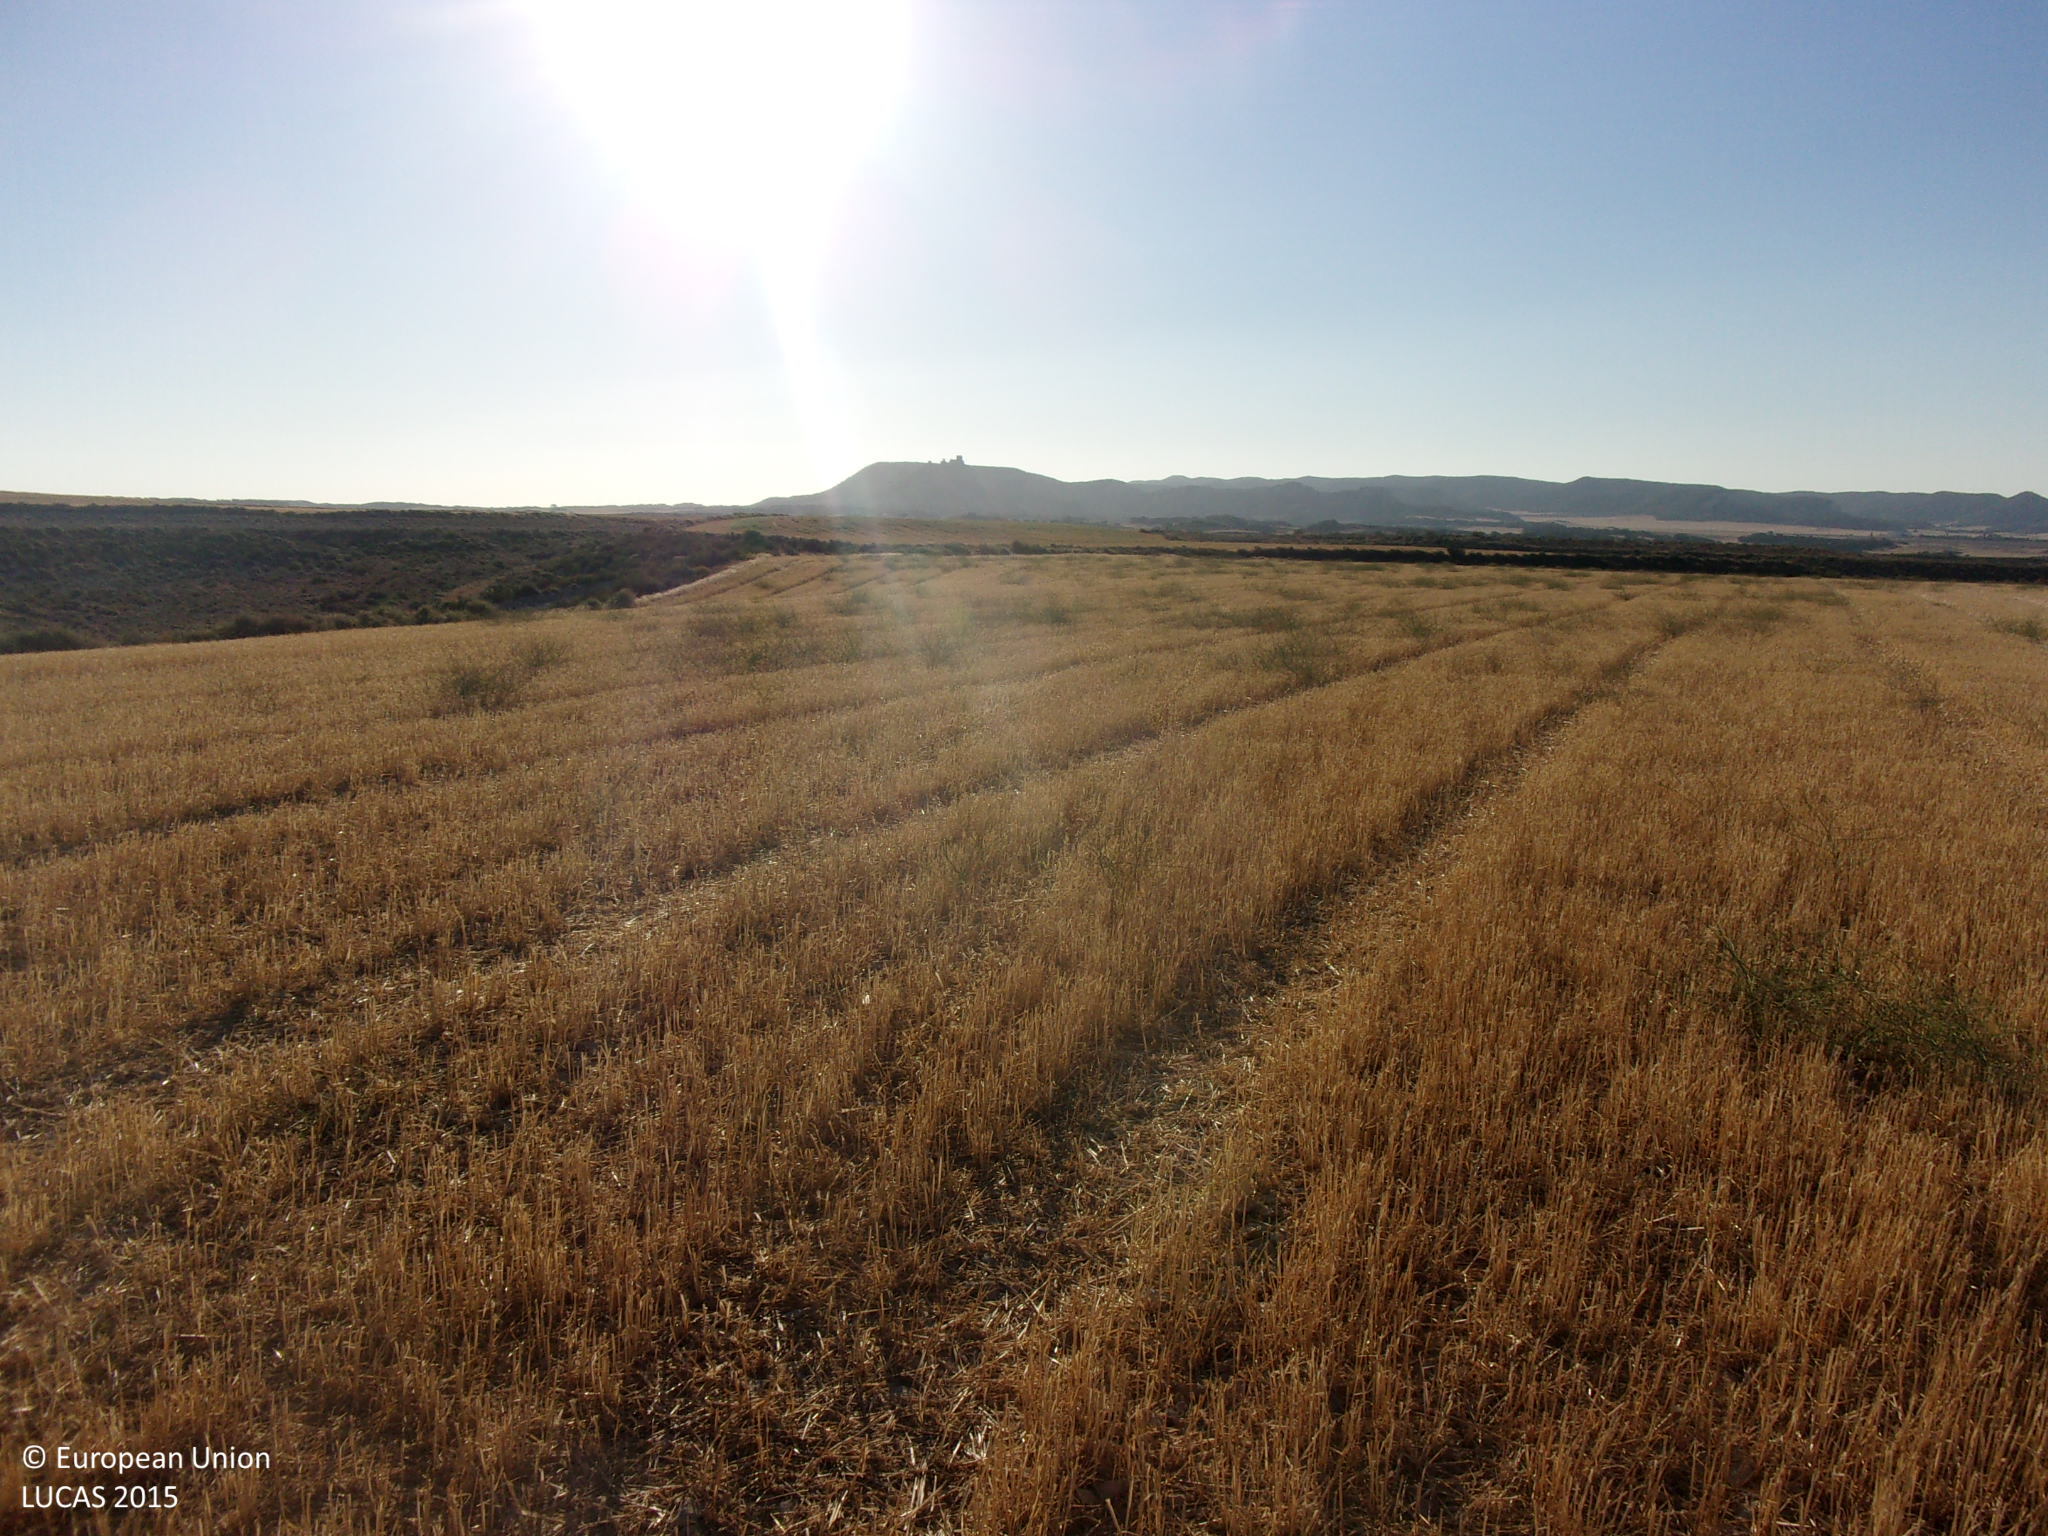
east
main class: Cropland
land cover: Barley
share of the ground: < 10 %
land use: Agriculture (excluding fallow land and kitchen gardens)
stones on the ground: > 50 %
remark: Harvested field
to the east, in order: Barley; Shrubland without tree cover; Rock outcrops; Tracks; Rock outcrops; Shrubland without tree cover; Durum wheat
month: July
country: ES
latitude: 42.0236
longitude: -1.1018
